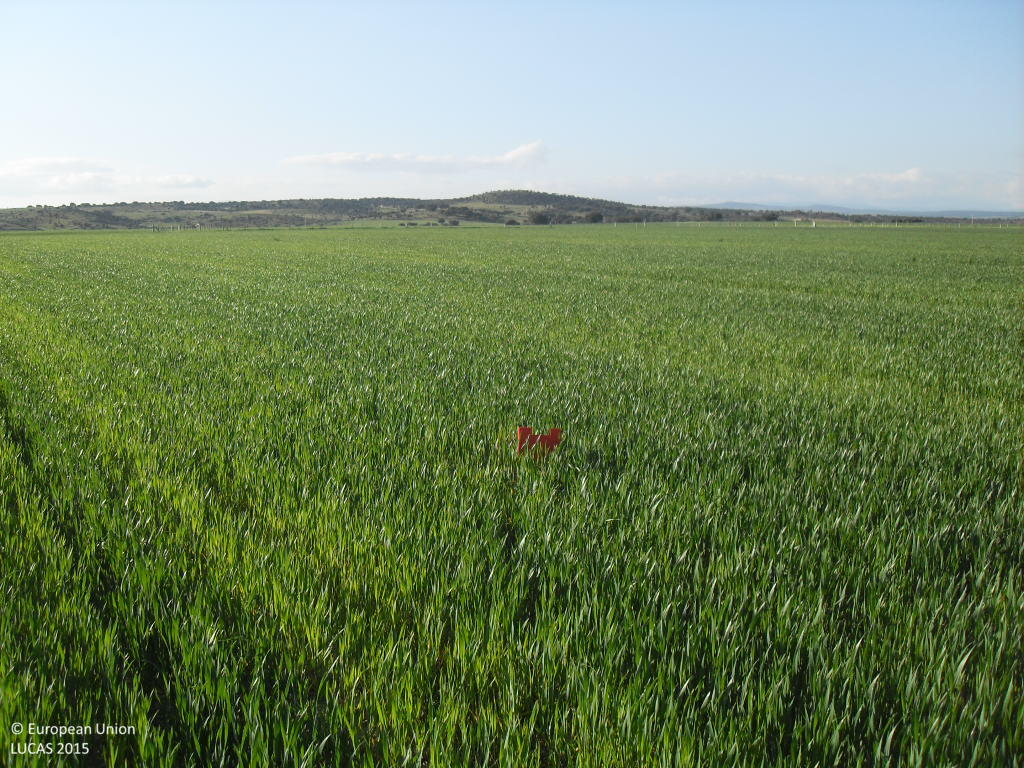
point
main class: Cropland
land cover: Oats
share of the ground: > 75 %
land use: Agriculture (excluding fallow land and kitchen gardens)
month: April
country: ES
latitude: 40.7551
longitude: -5.2635
